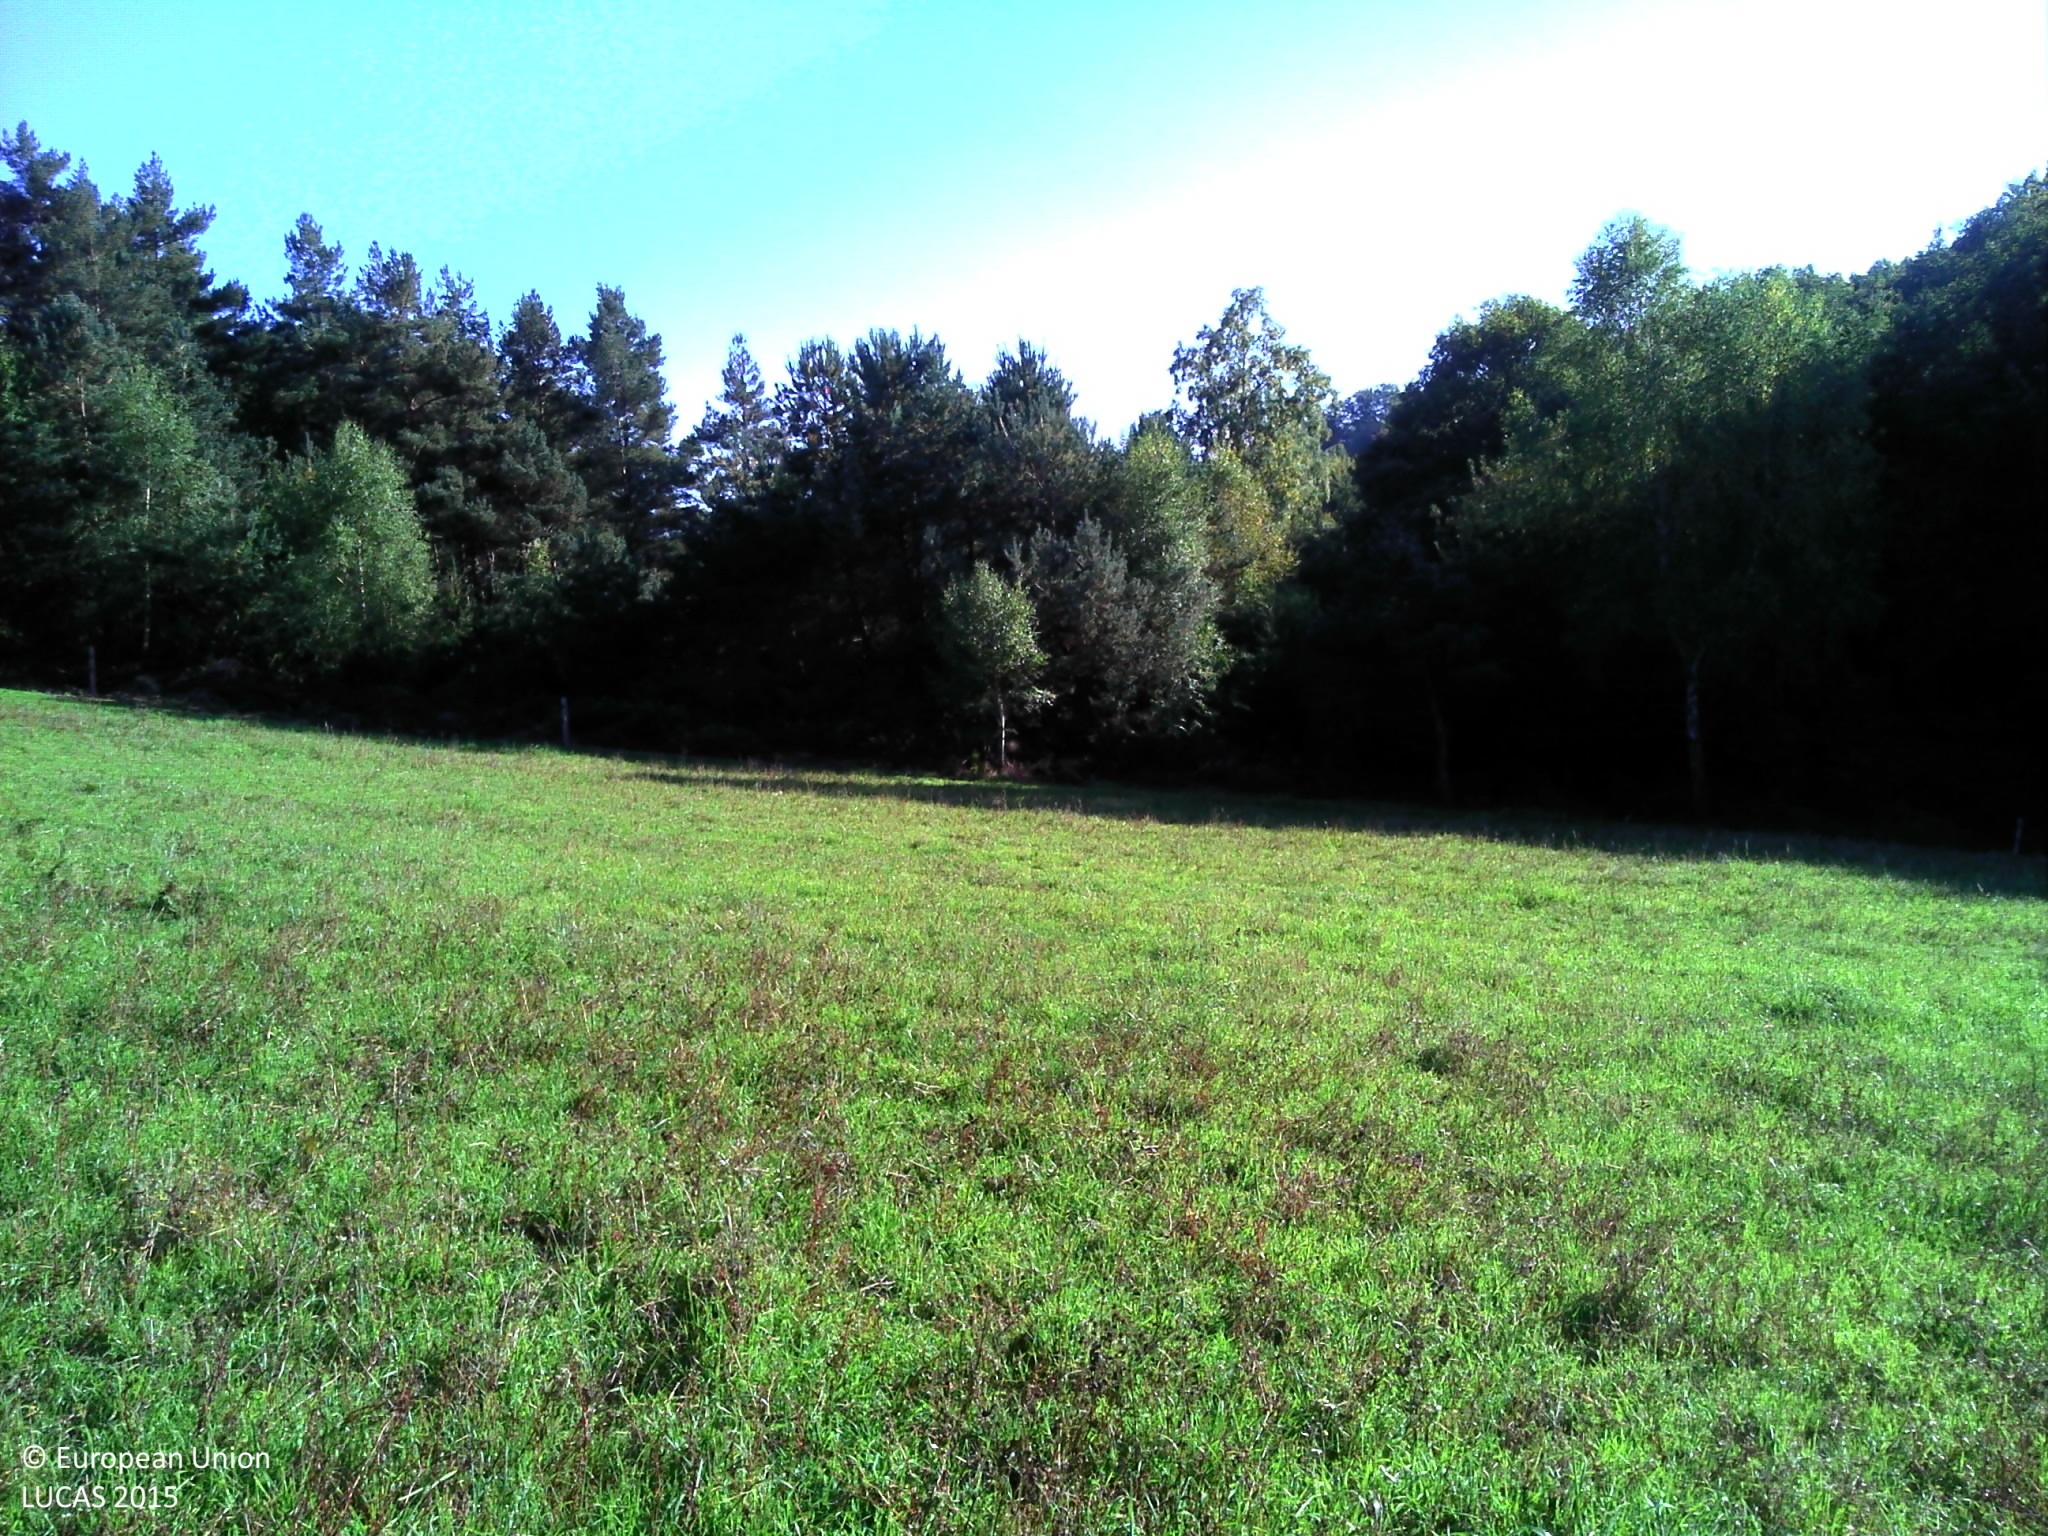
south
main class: Grassland
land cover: Grassland without tree/shrub cover
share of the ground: > 75 %
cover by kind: herbaceous plants 100 %
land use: Agriculture (excluding fallow land and kitchen gardens)
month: September
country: FR
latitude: 45.8014
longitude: 2.8063
